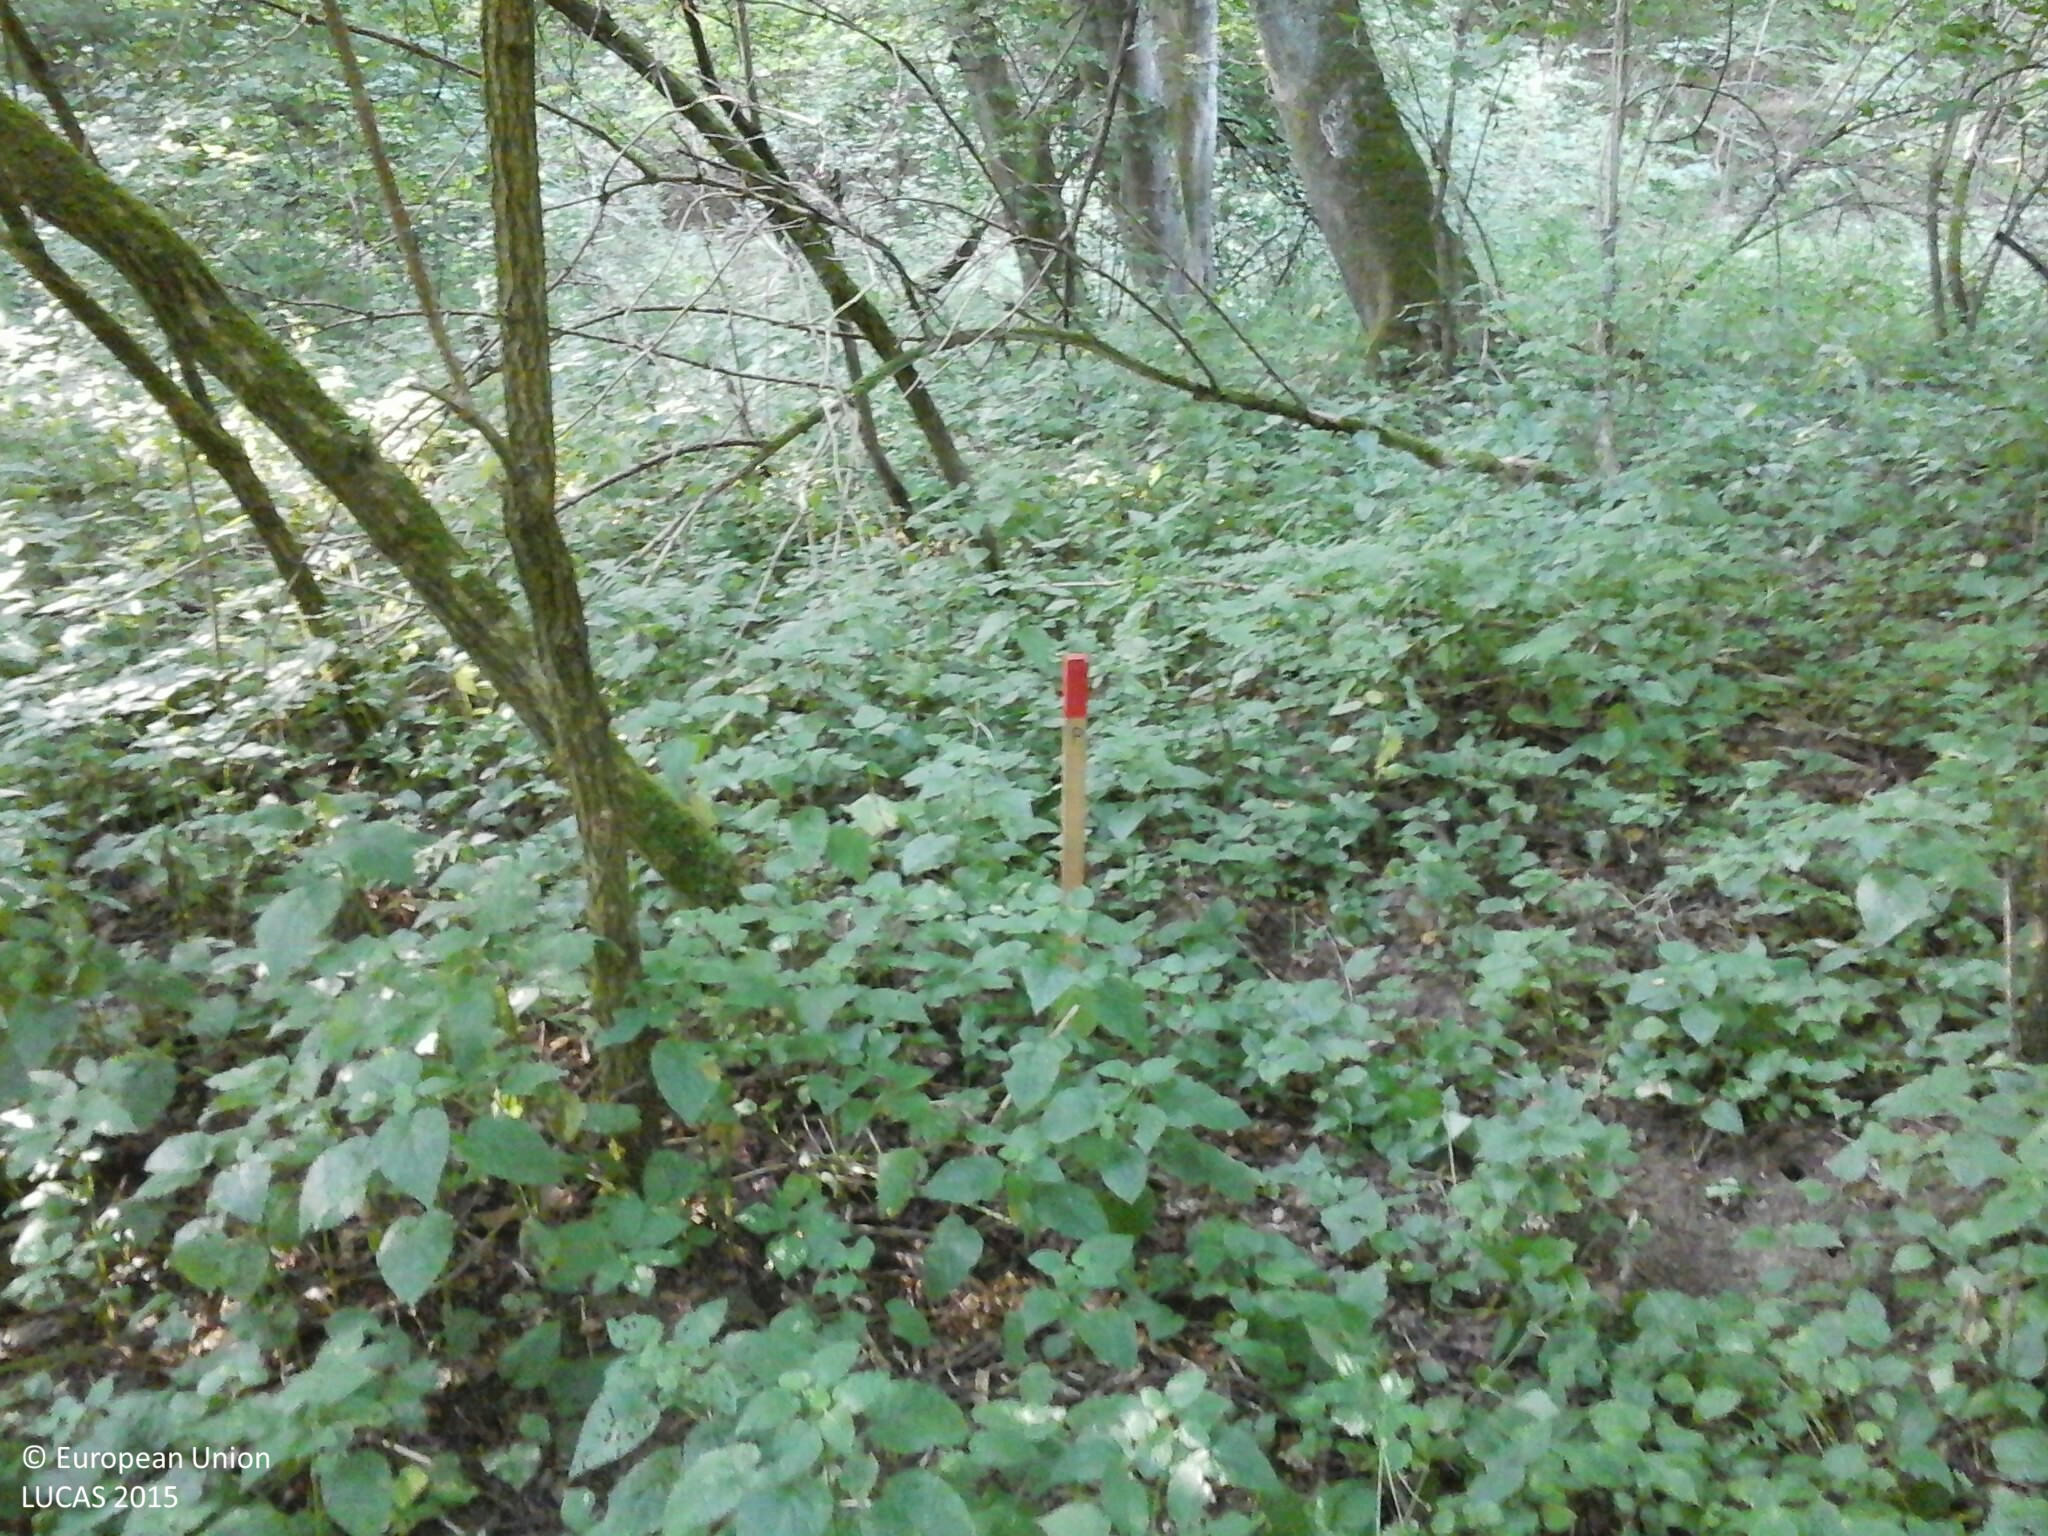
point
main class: Woodland
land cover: Broadleaved woodland
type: mesophytic deciduous forest
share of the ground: > 75 %
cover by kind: broadleaved forest trees 85 %, shrubs 10 %, herbaceous plants 5 %
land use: Forestry
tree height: > 5 m
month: July
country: HU
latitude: 46.9479
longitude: 16.5059
